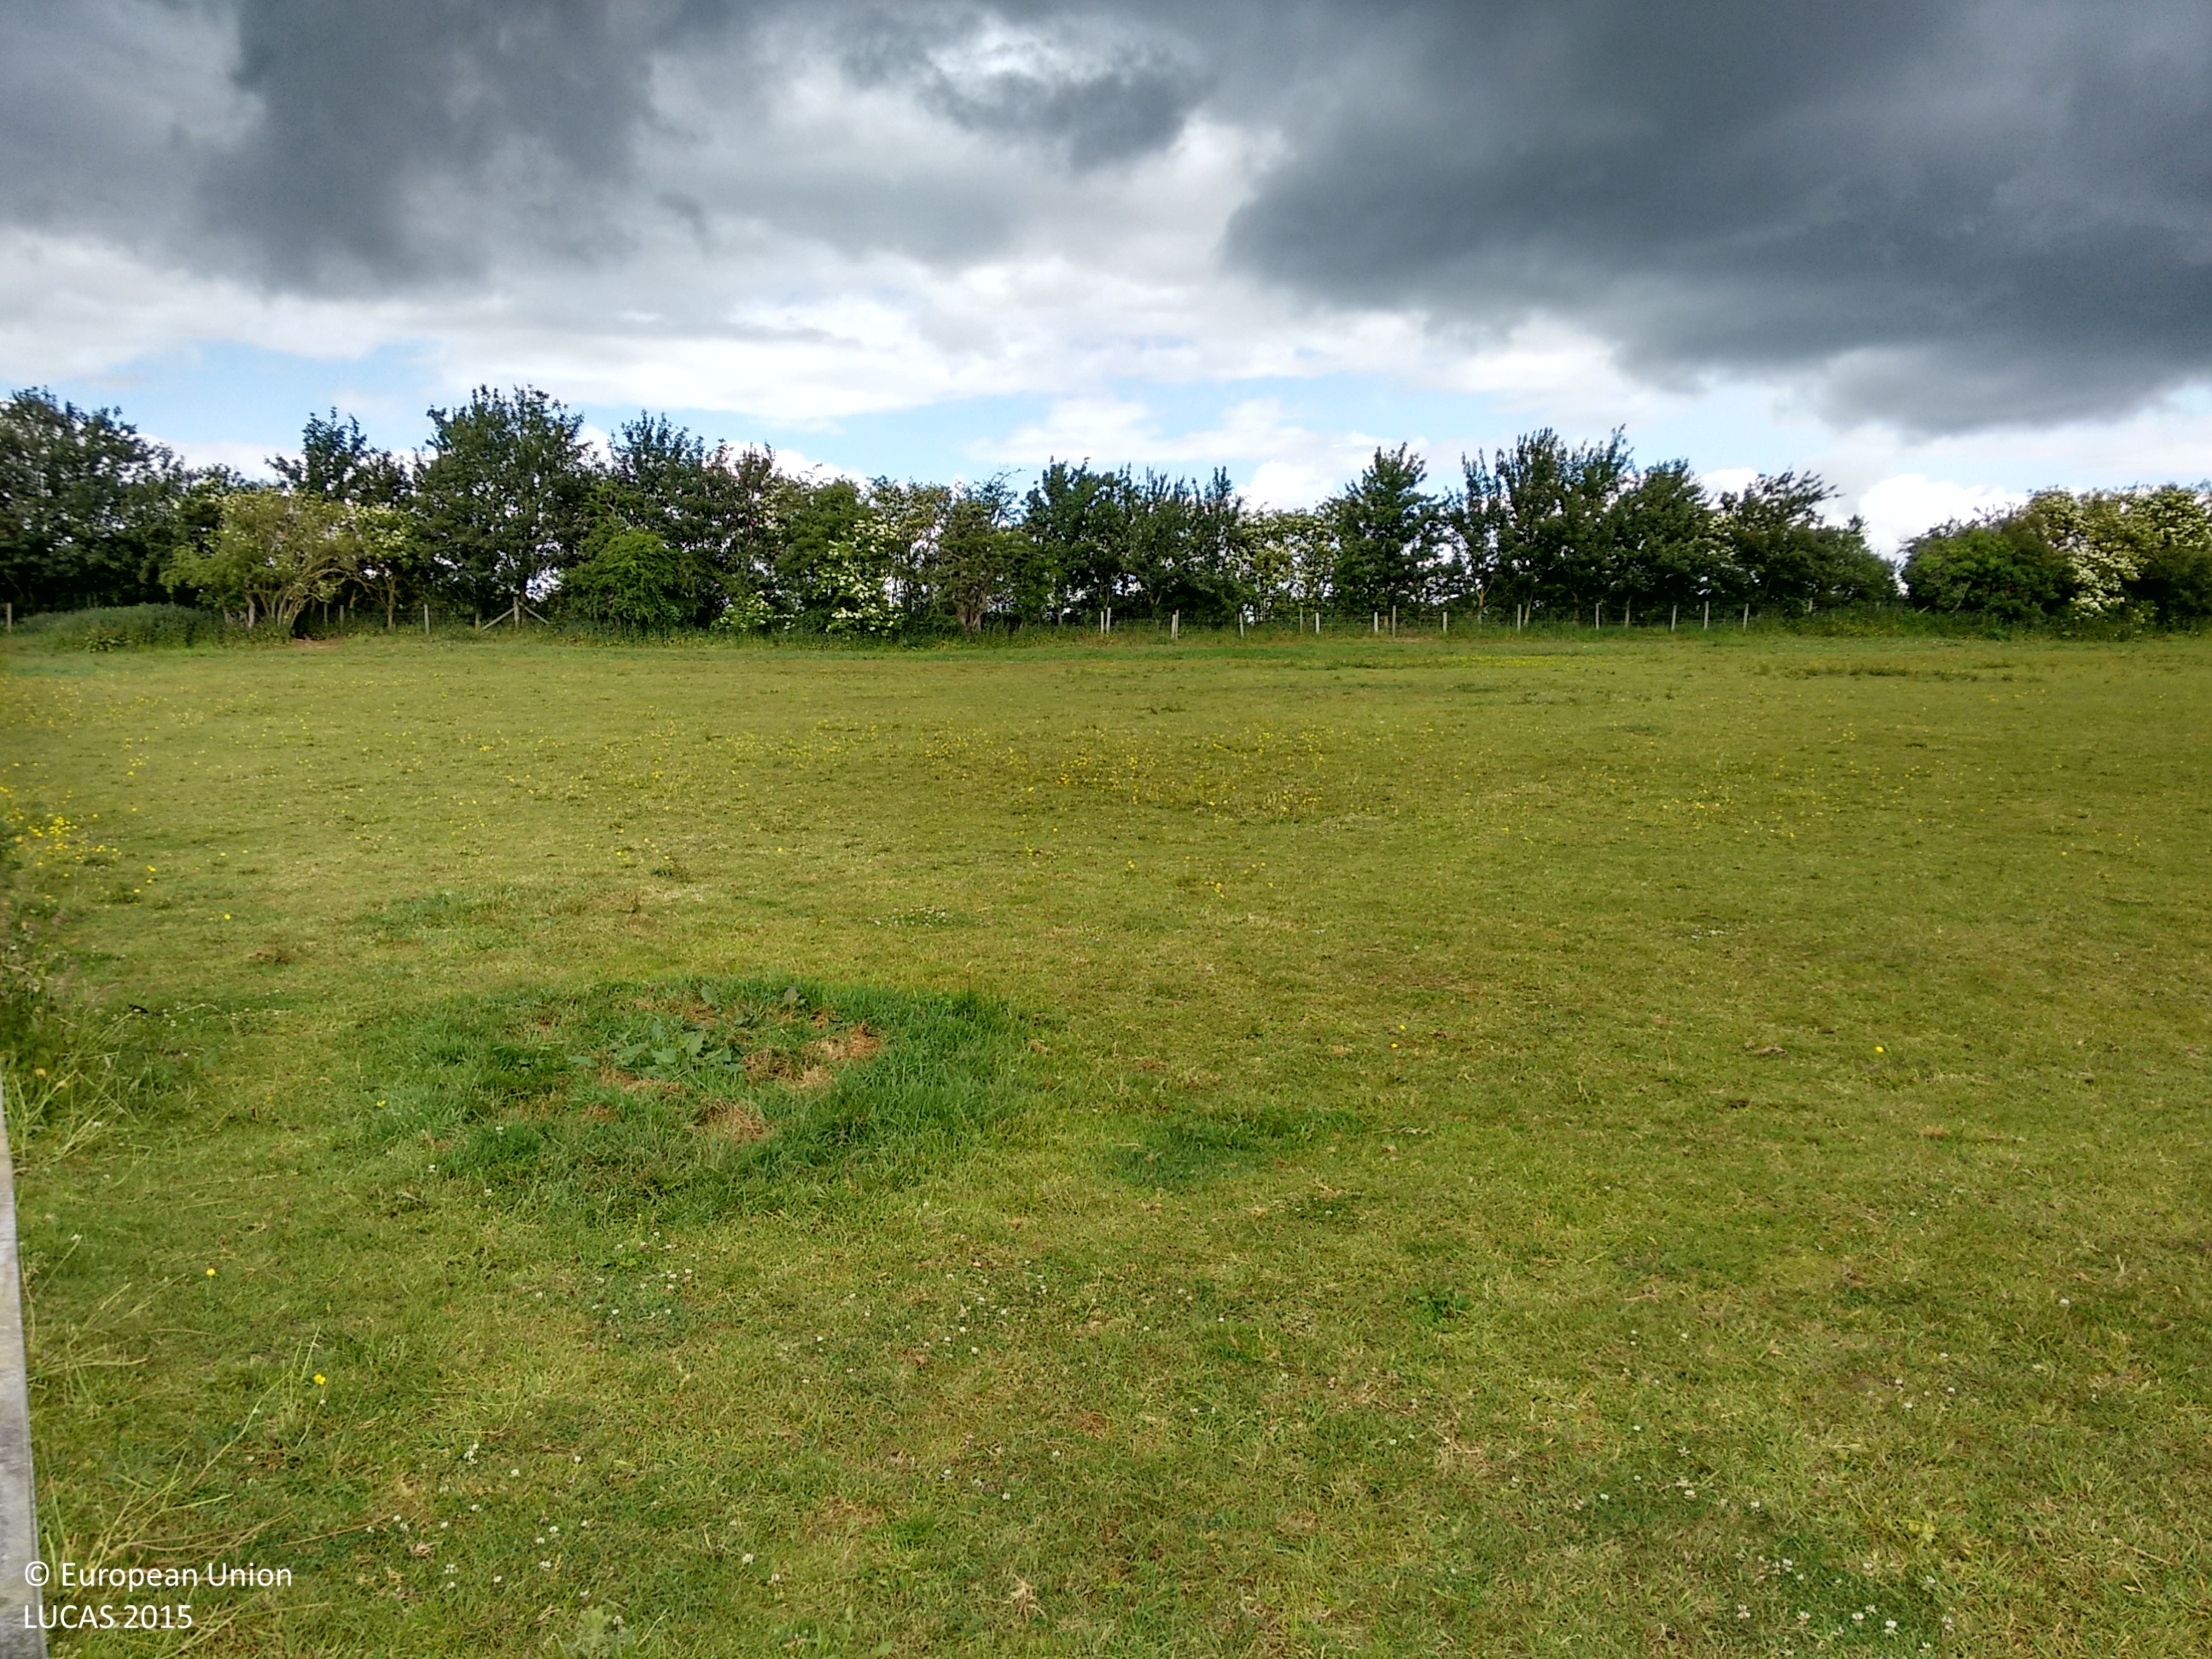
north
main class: Grassland
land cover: Grassland without tree/shrub cover
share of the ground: > 75 %
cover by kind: herbaceous plants 100 %
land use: Agriculture (excluding fallow land and kitchen gardens)
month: June
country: GB
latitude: 51.5145
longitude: -1.2443
